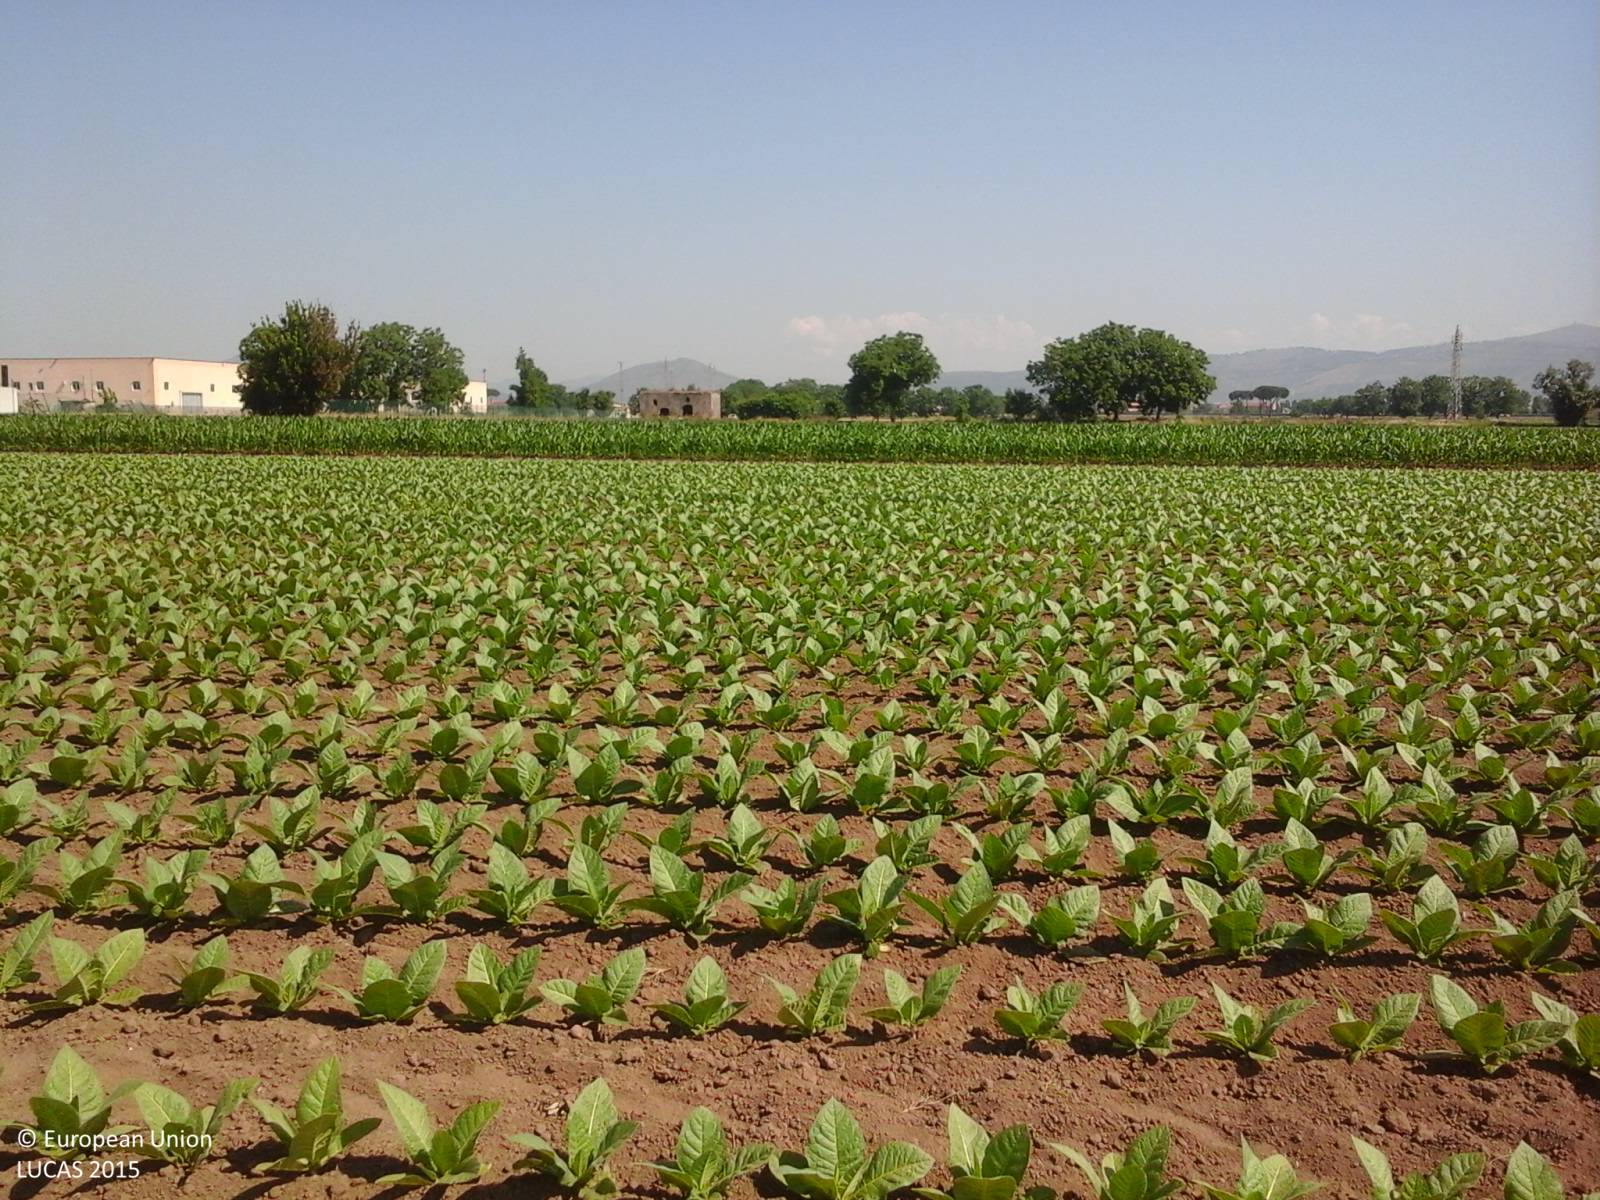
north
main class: Cropland
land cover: Tobacco
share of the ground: 25 - 50 %
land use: Agriculture (excluding fallow land and kitchen gardens)
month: June
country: IT
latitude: 41.0225
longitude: 14.3471
